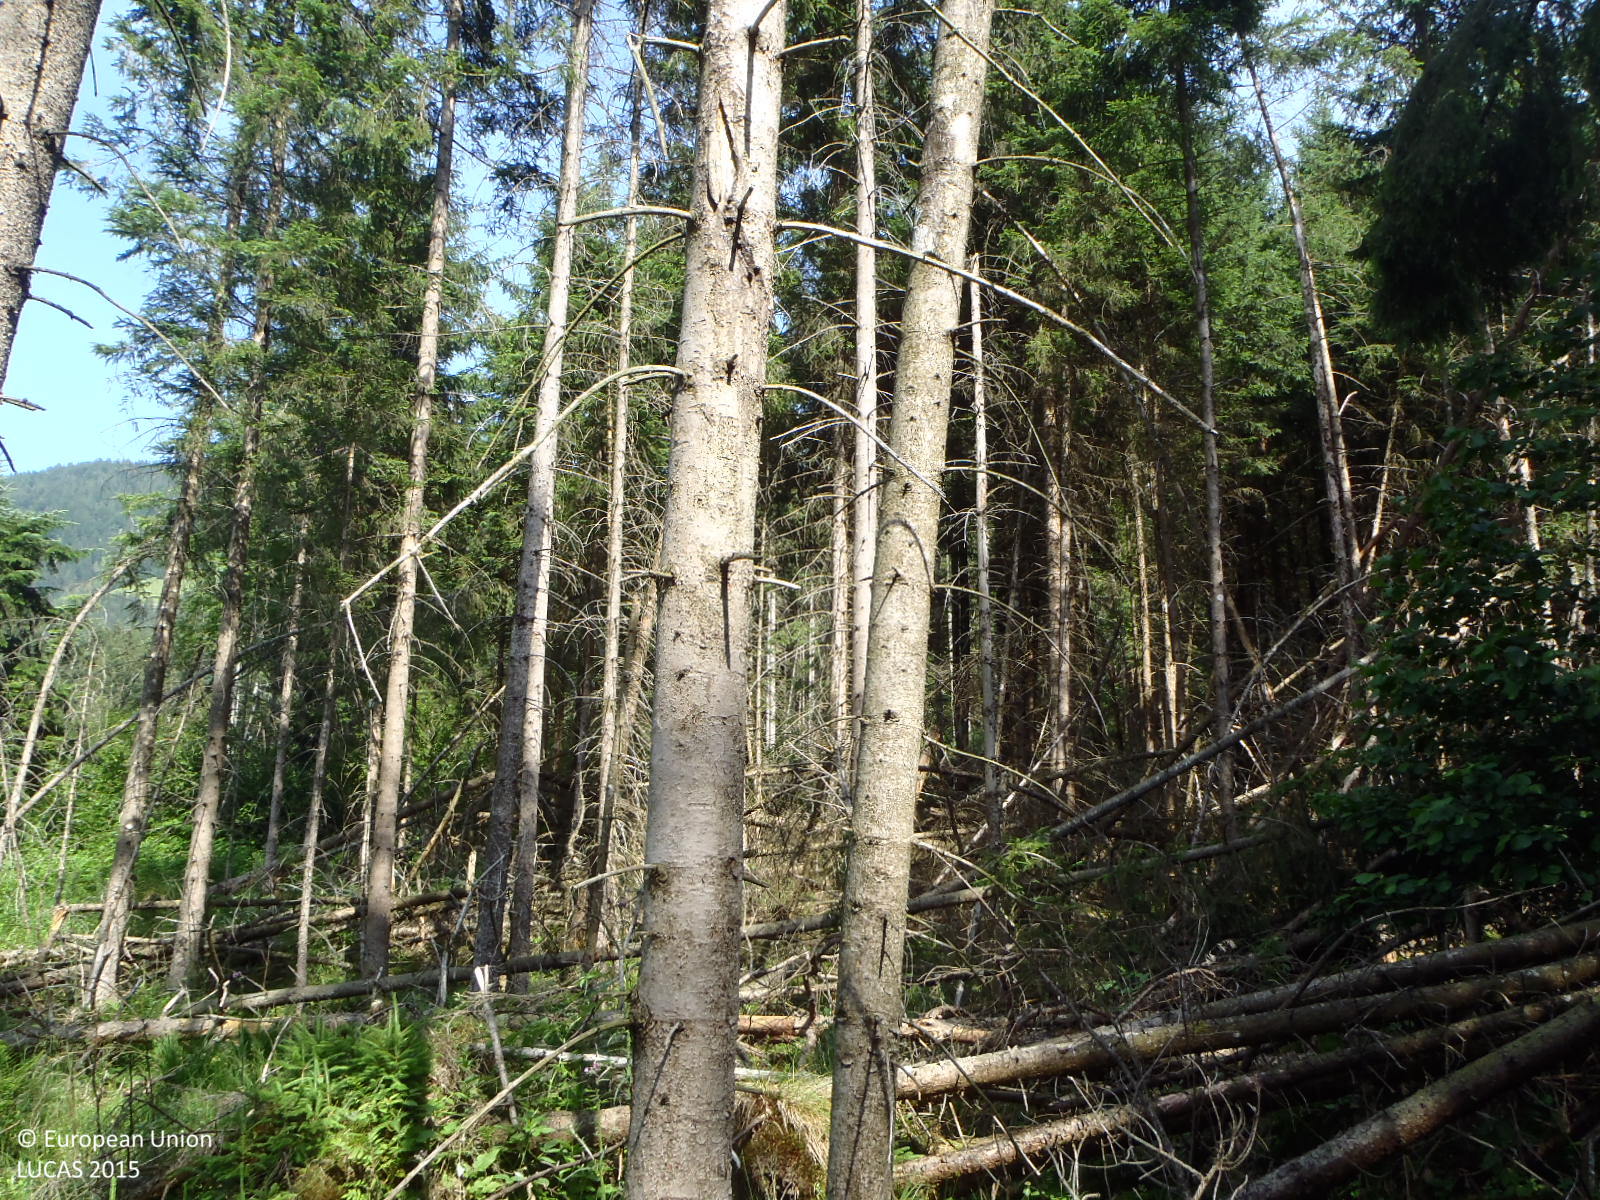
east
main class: Woodland
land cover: Spruce dominated coniferous woodland
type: alpine coniferous forest
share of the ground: 50 - 75 %
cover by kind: coniferous forest trees 60 %, herbaceous plants 20 %, shrubs 10 %, broadleaved forest trees 5 %, lichens and mosses 5 %
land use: Forestry
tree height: > 5 m
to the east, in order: Spruce dominated coniferous woodland; Shrubland with sparse tree cover; Spruce dominated mixed woodland; Rivers and streams; Spruce dominated mixed woodland; Shrubland with sparse tree cover; Spruce dominated mixed woodland
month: July
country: AT
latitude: 47.5300
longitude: 12.4557
